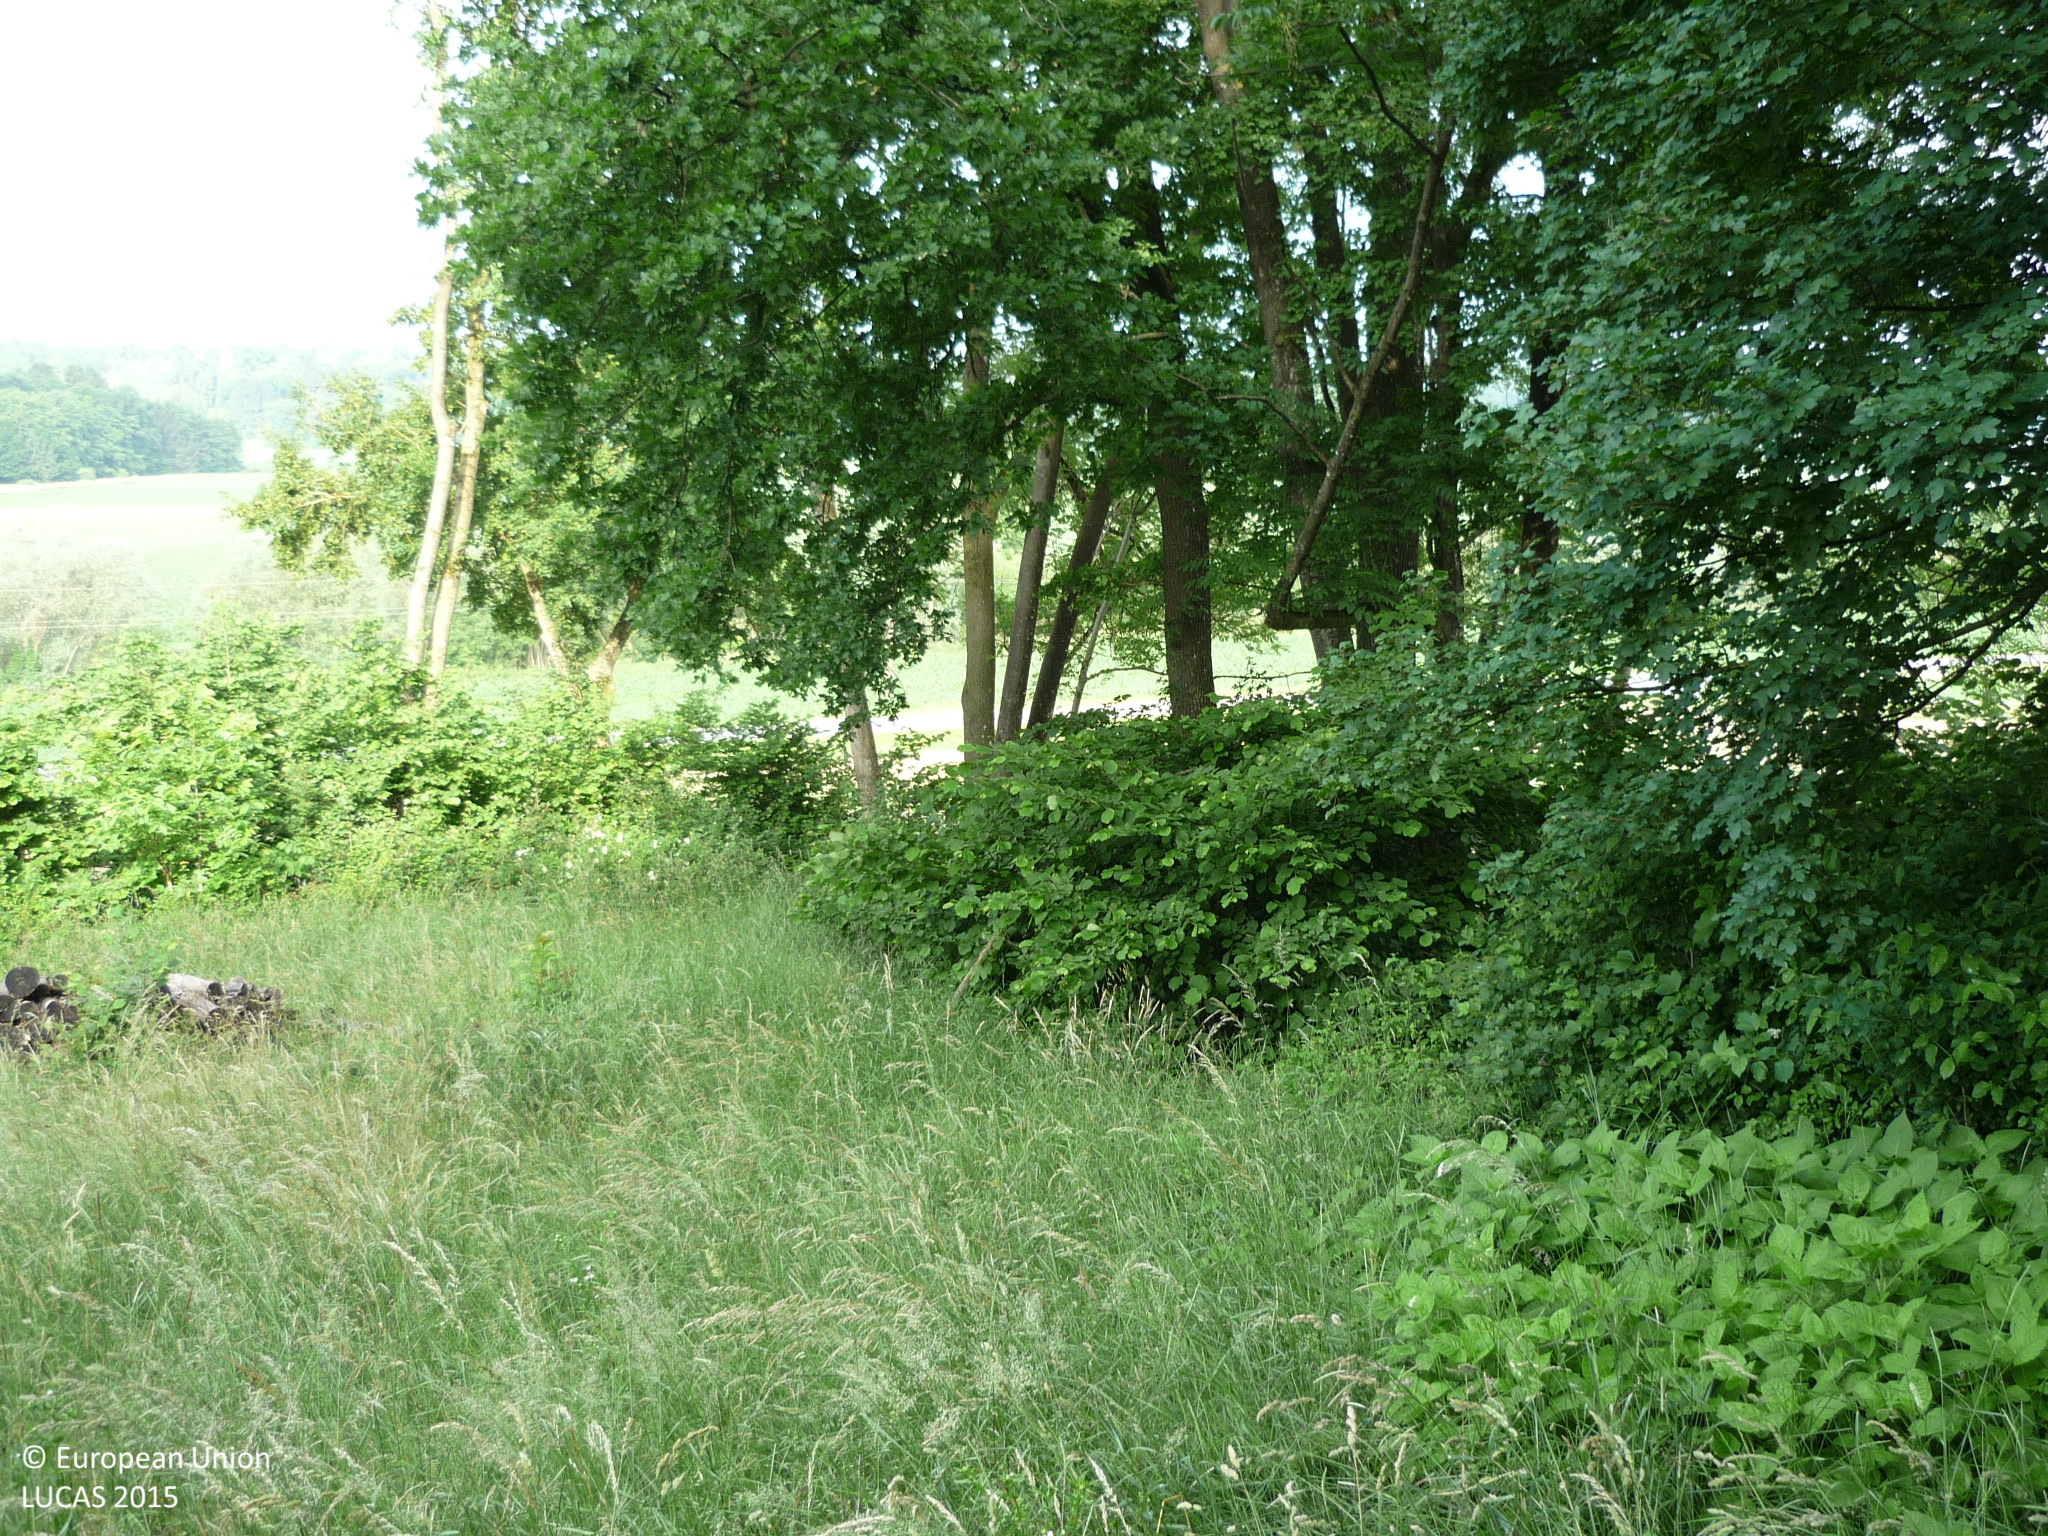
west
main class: Grassland
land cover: Grassland without tree/shrub cover
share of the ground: > 75 %
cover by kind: herbaceous plants 100 %
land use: Agriculture (excluding fallow land and kitchen gardens)
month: June
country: AT
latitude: 46.8157
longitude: 15.6485
